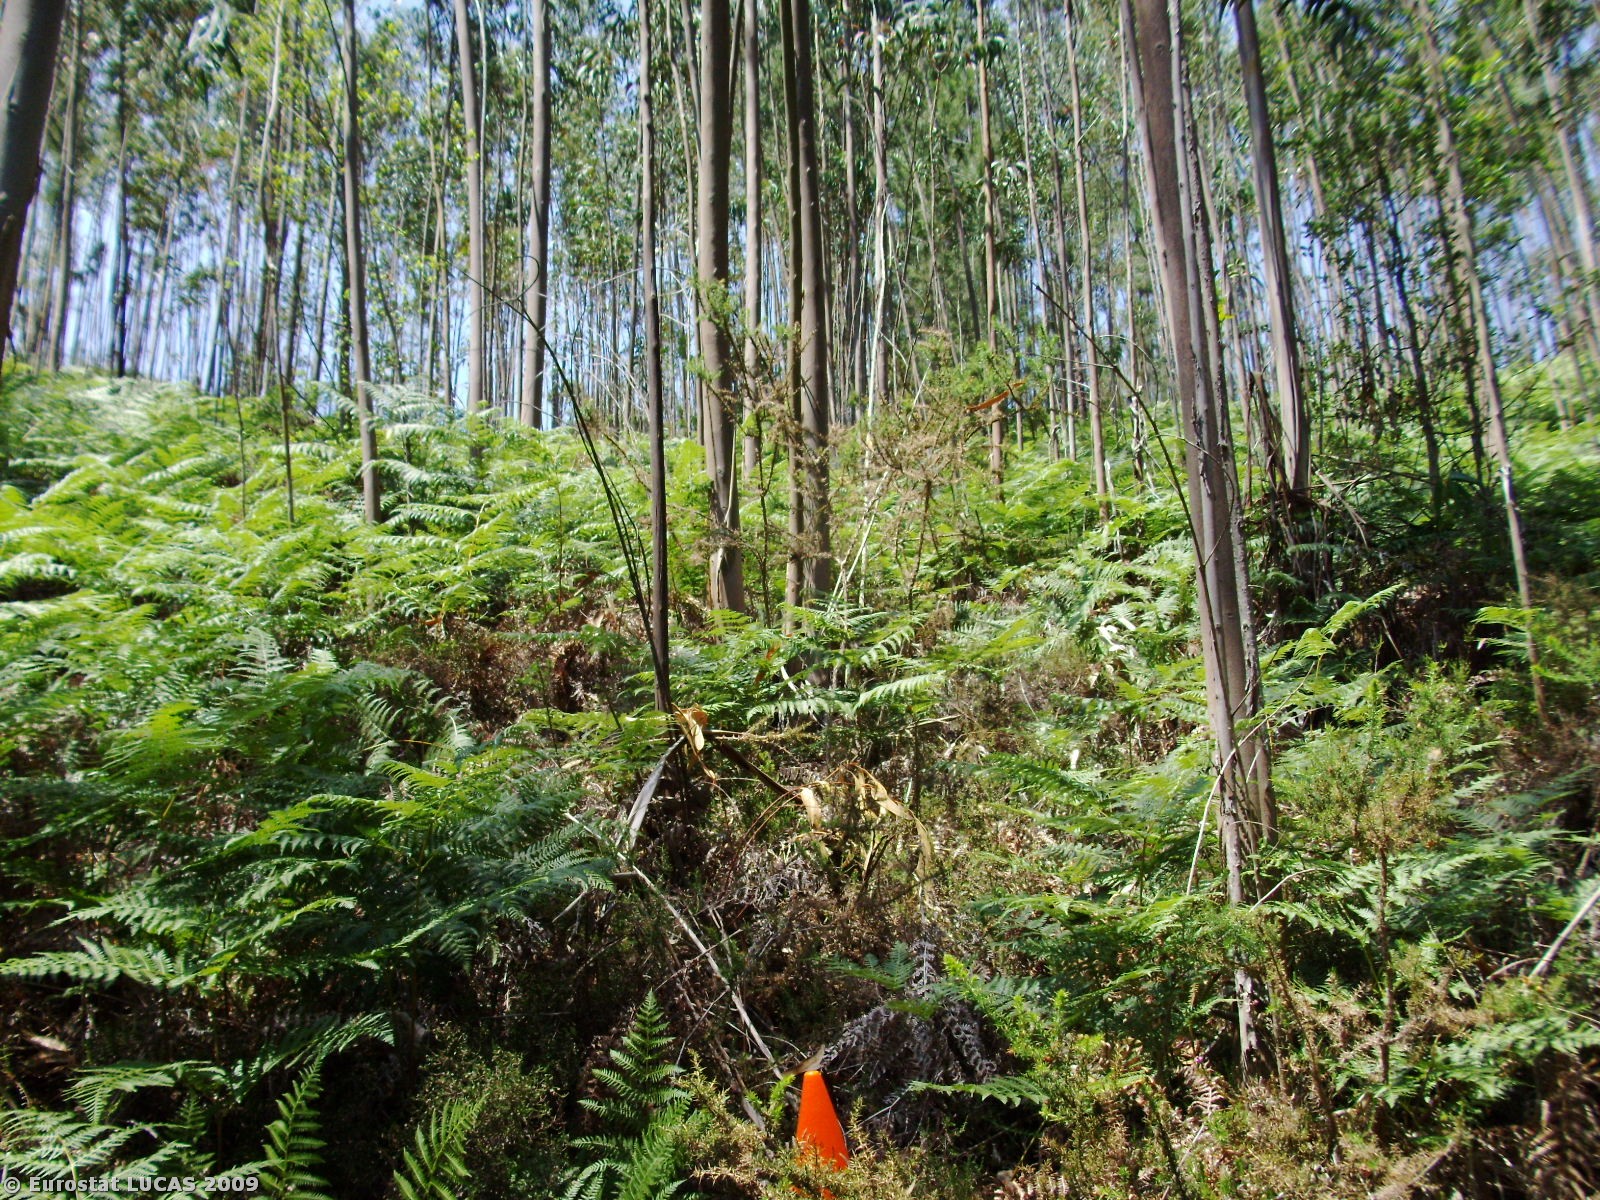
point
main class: Woodland
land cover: Broadleaved woodland
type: plantations and self-sown exotic forest
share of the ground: > 75 %
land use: Forestry
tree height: > 5 m
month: May
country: PT
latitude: 40.2684
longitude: -8.3931
